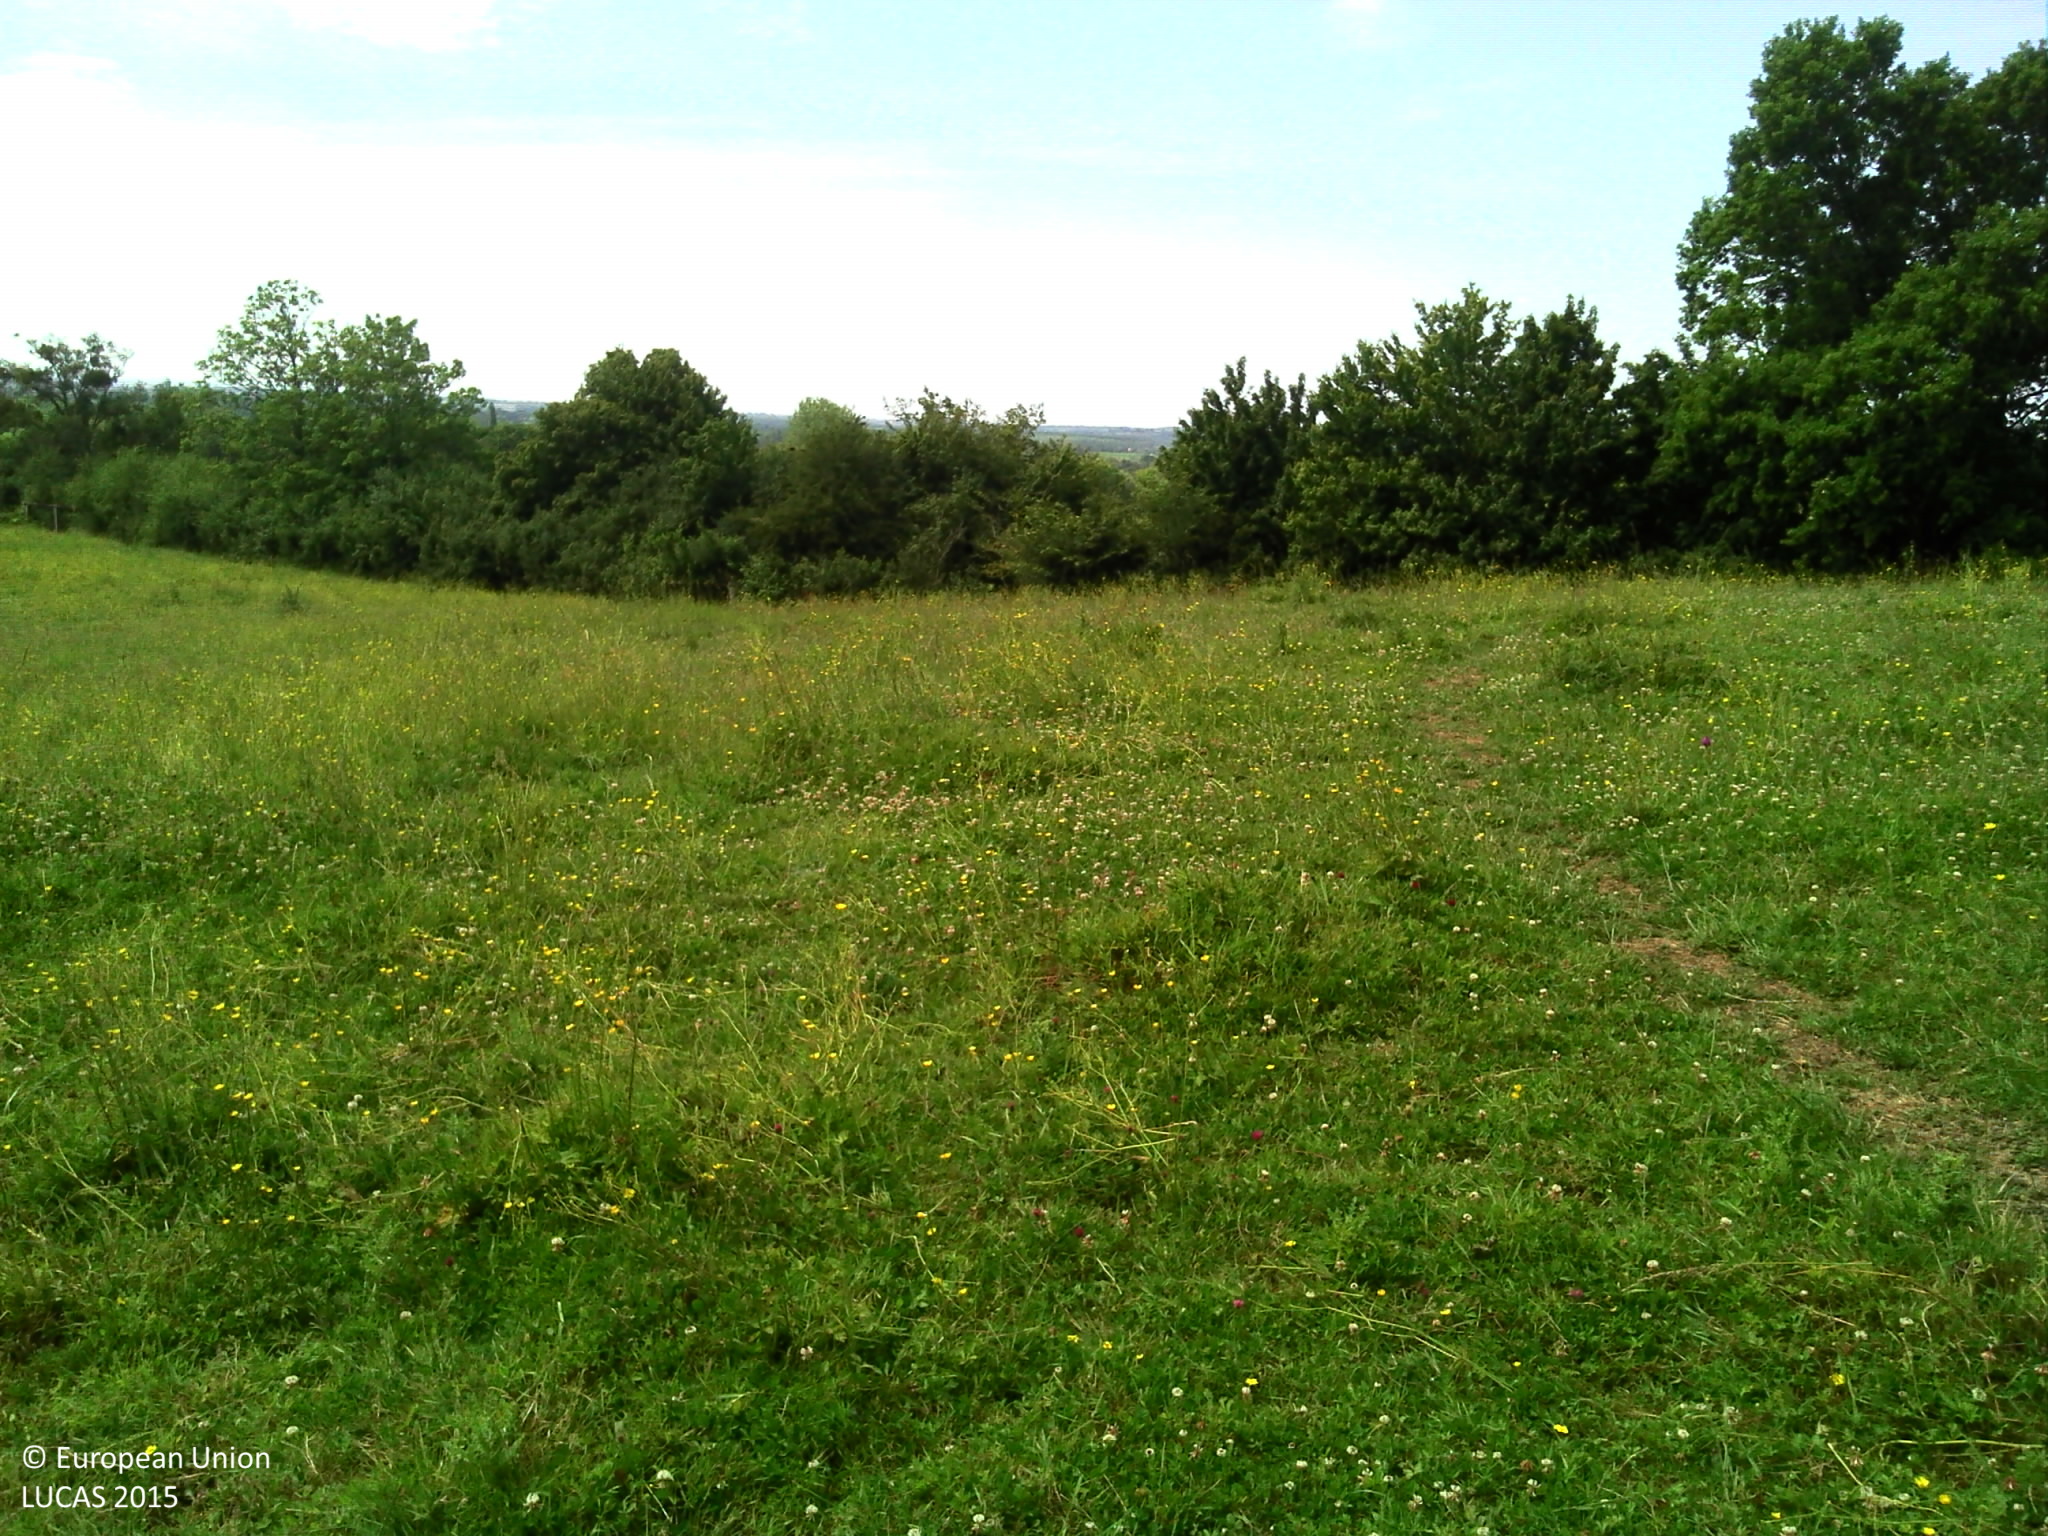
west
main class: Grassland
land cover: Grassland without tree/shrub cover
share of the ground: > 75 %
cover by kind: herbaceous plants 100 %
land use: Agriculture (excluding fallow land and kitchen gardens)
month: June
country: FR
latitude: 49.1966
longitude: -0.0356
